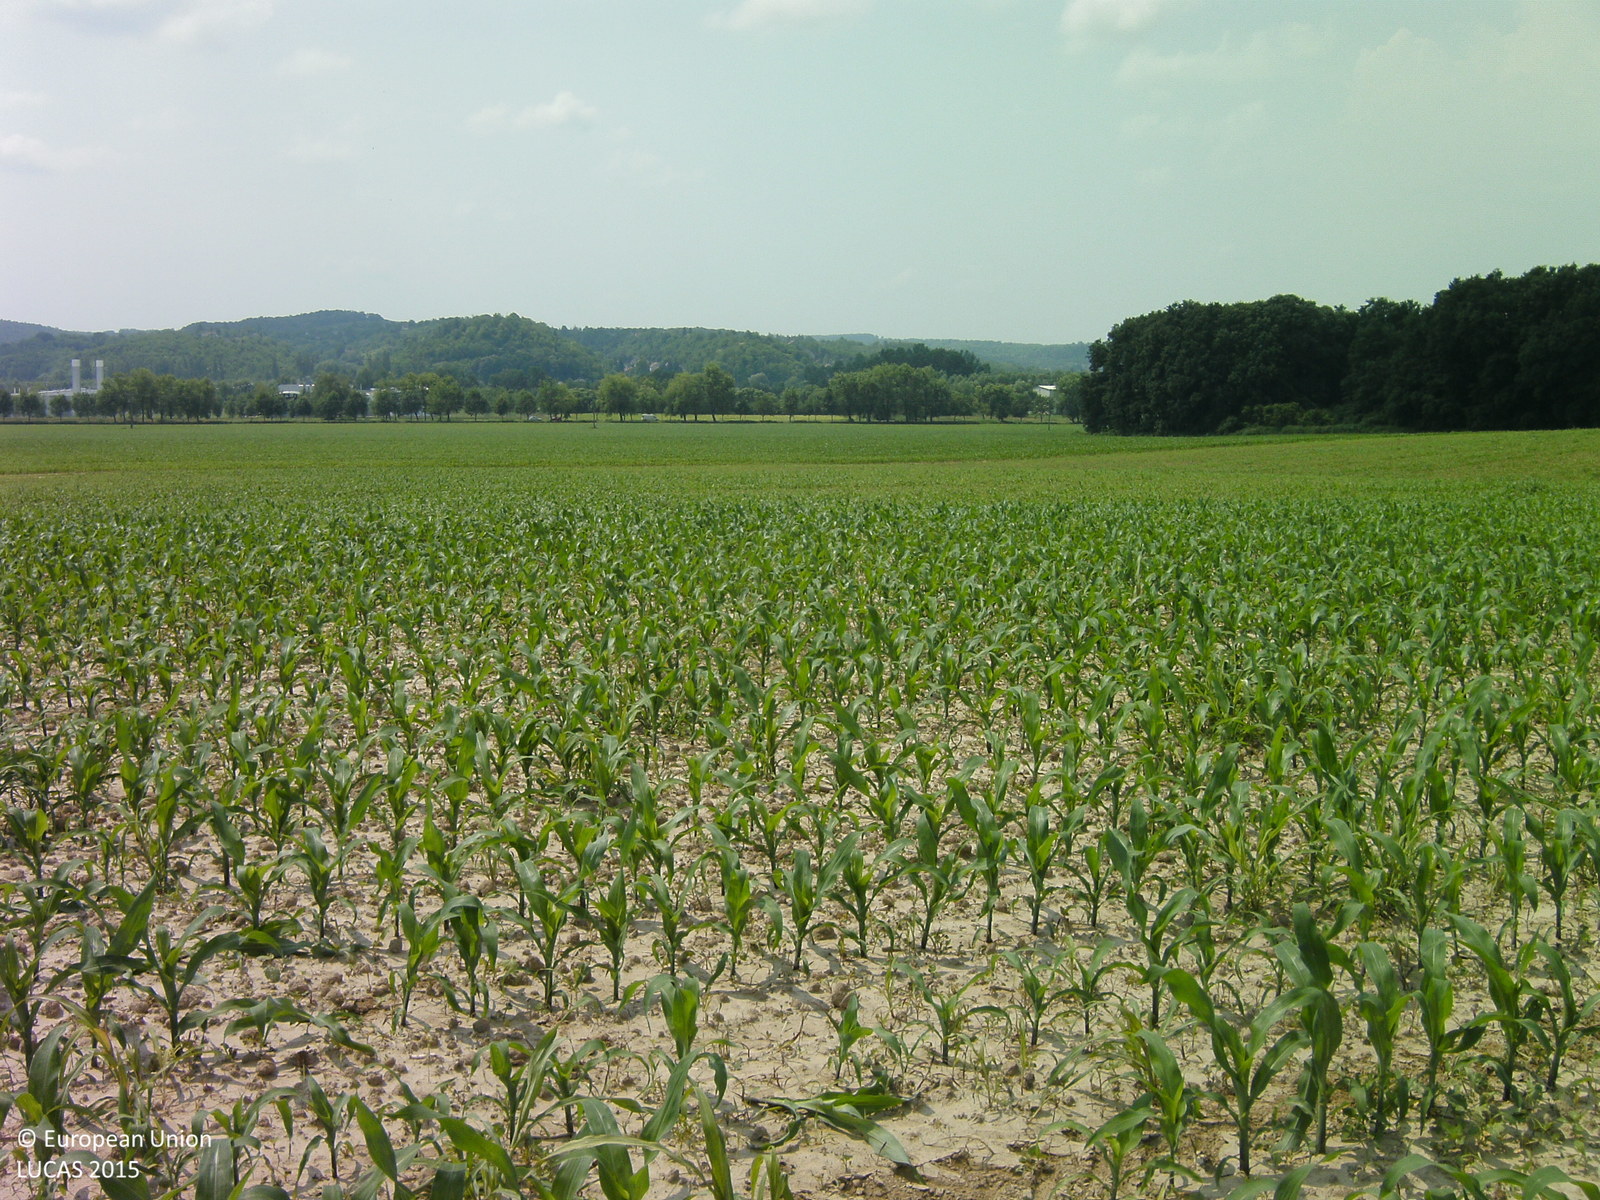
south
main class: Cropland
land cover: Maize
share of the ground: 10 - 25 %
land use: Agriculture (excluding fallow land and kitchen gardens)
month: June
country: HU
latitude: 46.3704
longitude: 17.8448
